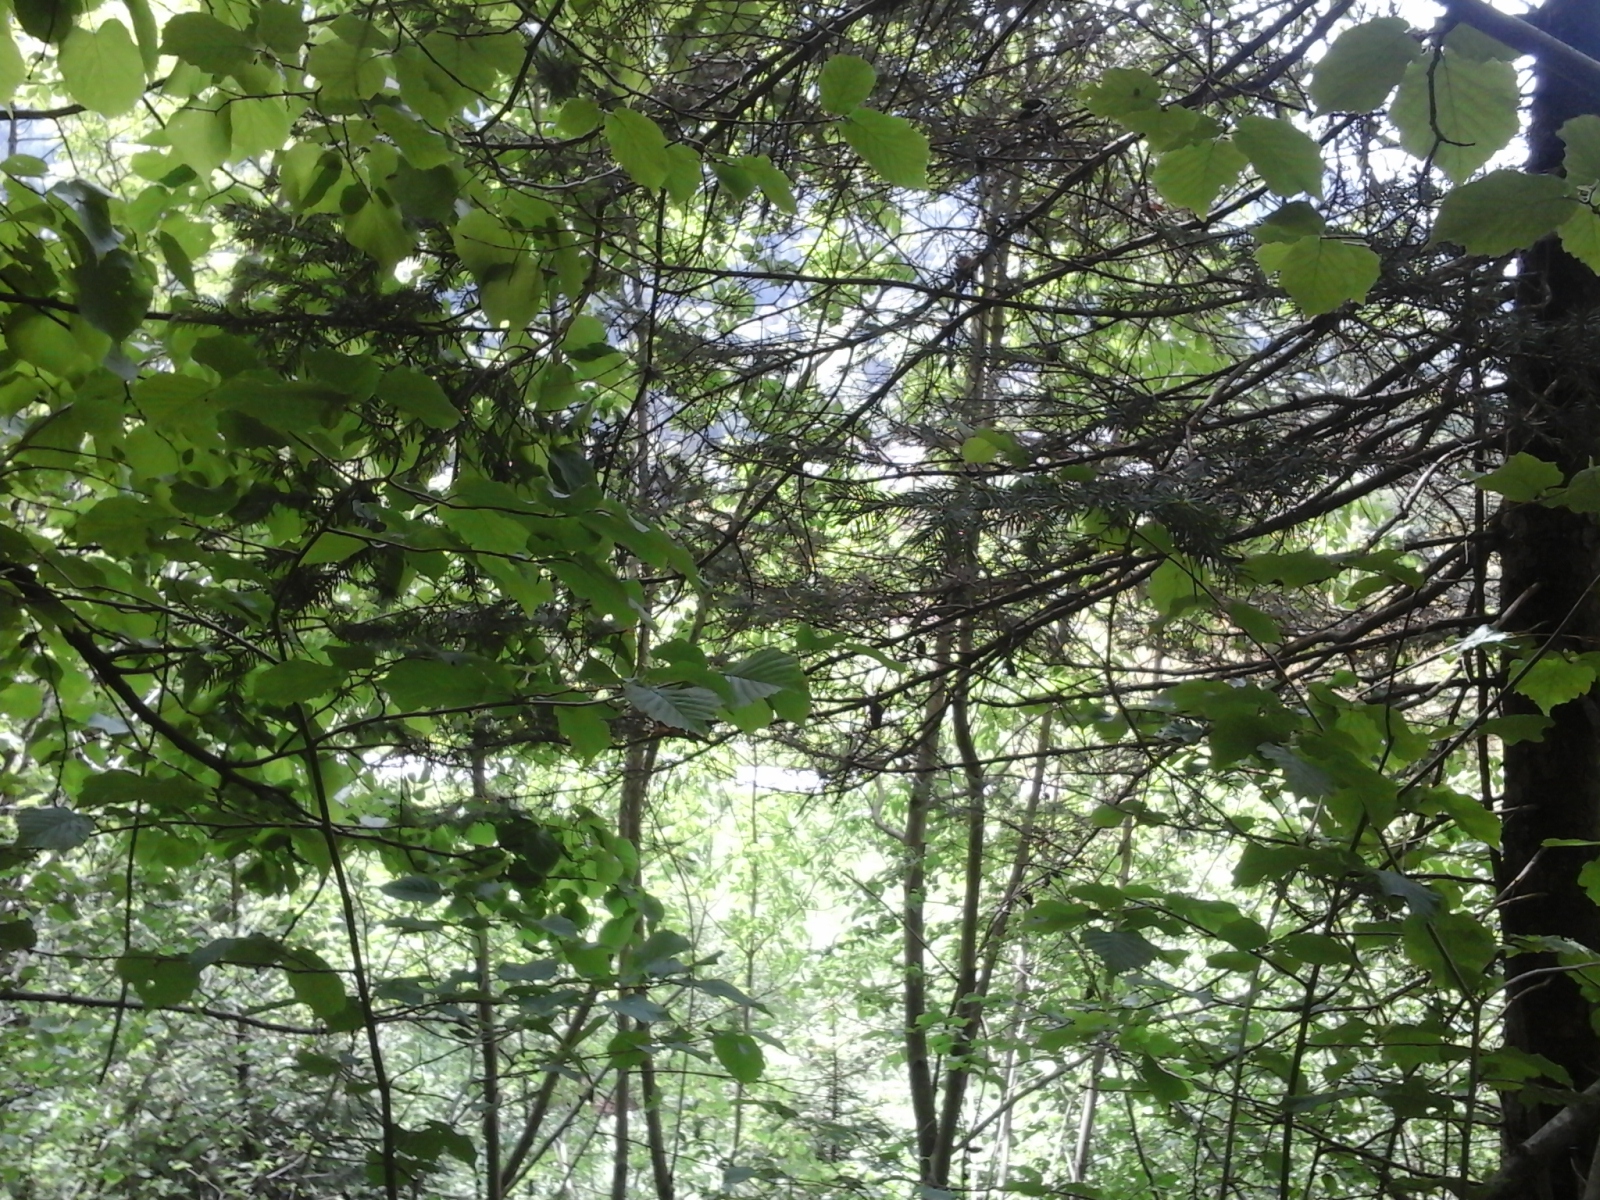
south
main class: Woodland
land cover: Other mixed woodland
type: alpine coniferous forest
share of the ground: > 75 %
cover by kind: broadleaved forest trees 75 %, coniferous forest trees 25 %
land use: Forestry
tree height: > 5 m
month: May
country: IT
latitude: 46.0424
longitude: 10.7355
